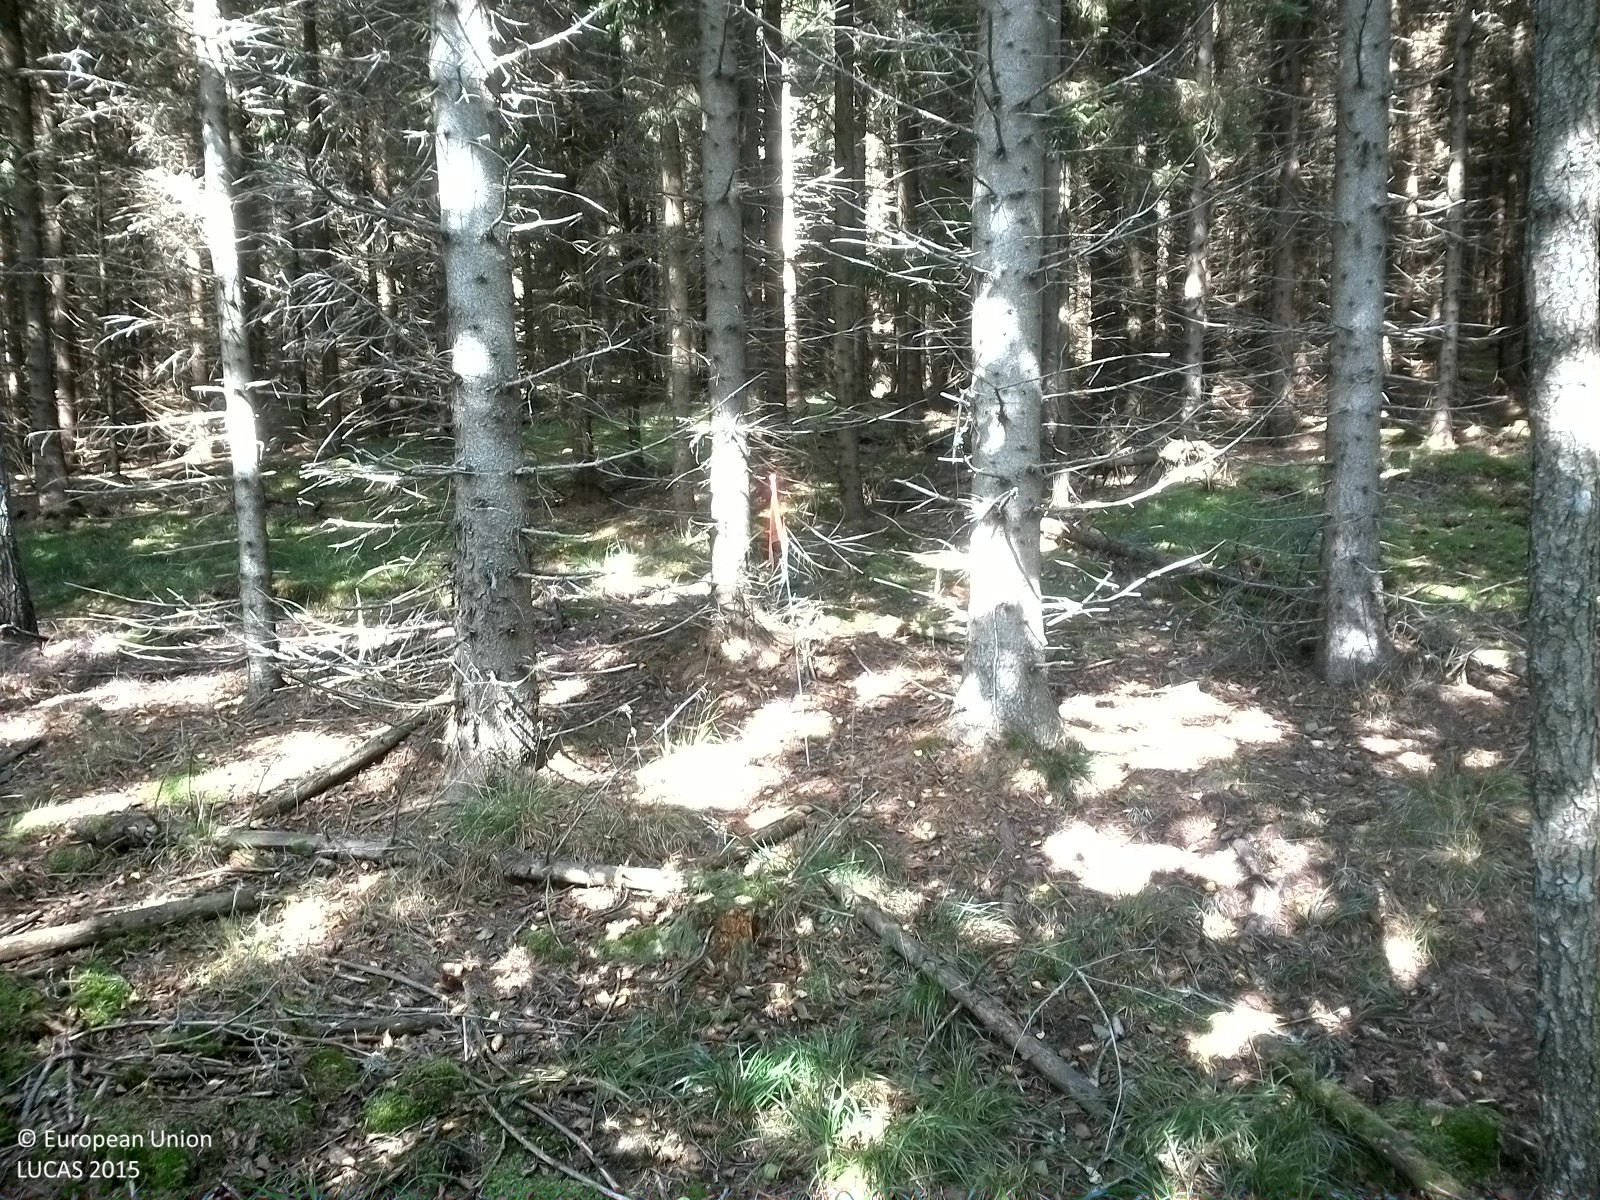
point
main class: Woodland
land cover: Spruce dominated coniferous woodland
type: boreal forest
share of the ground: 50 - 75 %
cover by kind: coniferous forest trees 70 %, herbaceous plants 10 %, lichens and mosses 10 %, unconsolidated bare surface 10 %
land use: Forestry
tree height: > 5 m
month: August
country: SE
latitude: 58.9489
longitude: 15.6420
